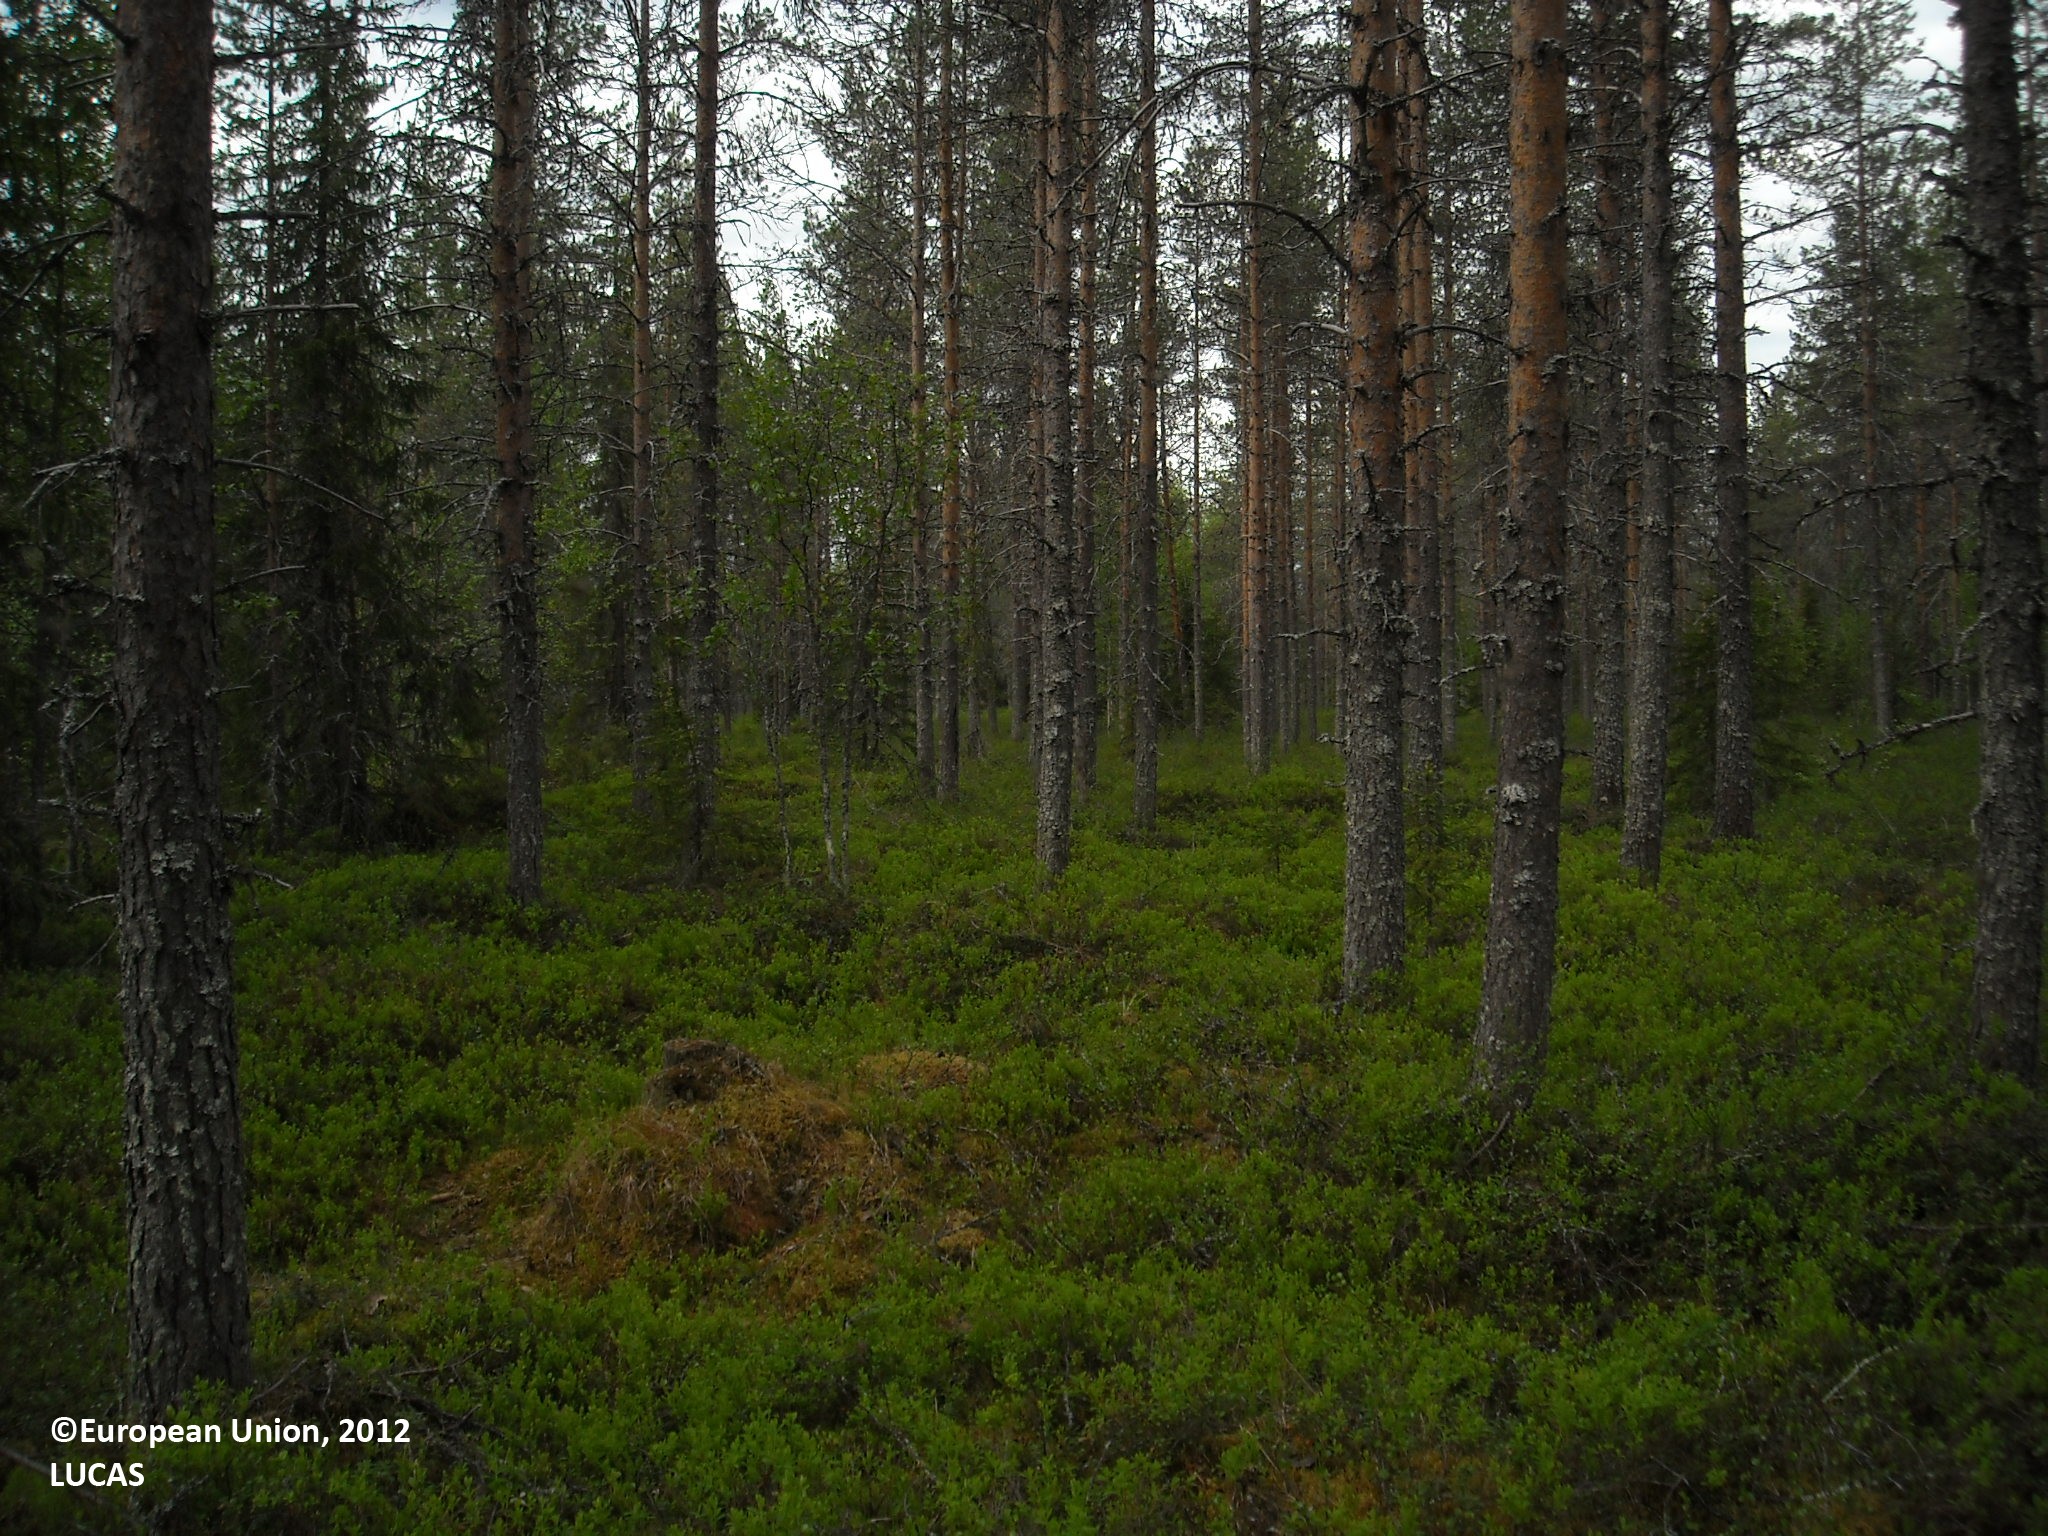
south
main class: Woodland
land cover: Pine dominated coniferous woodland
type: boreal forest
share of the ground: 50 - 75 %
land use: Forestry
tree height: > 5 m
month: June
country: FI
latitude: 65.5897
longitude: 28.0353
